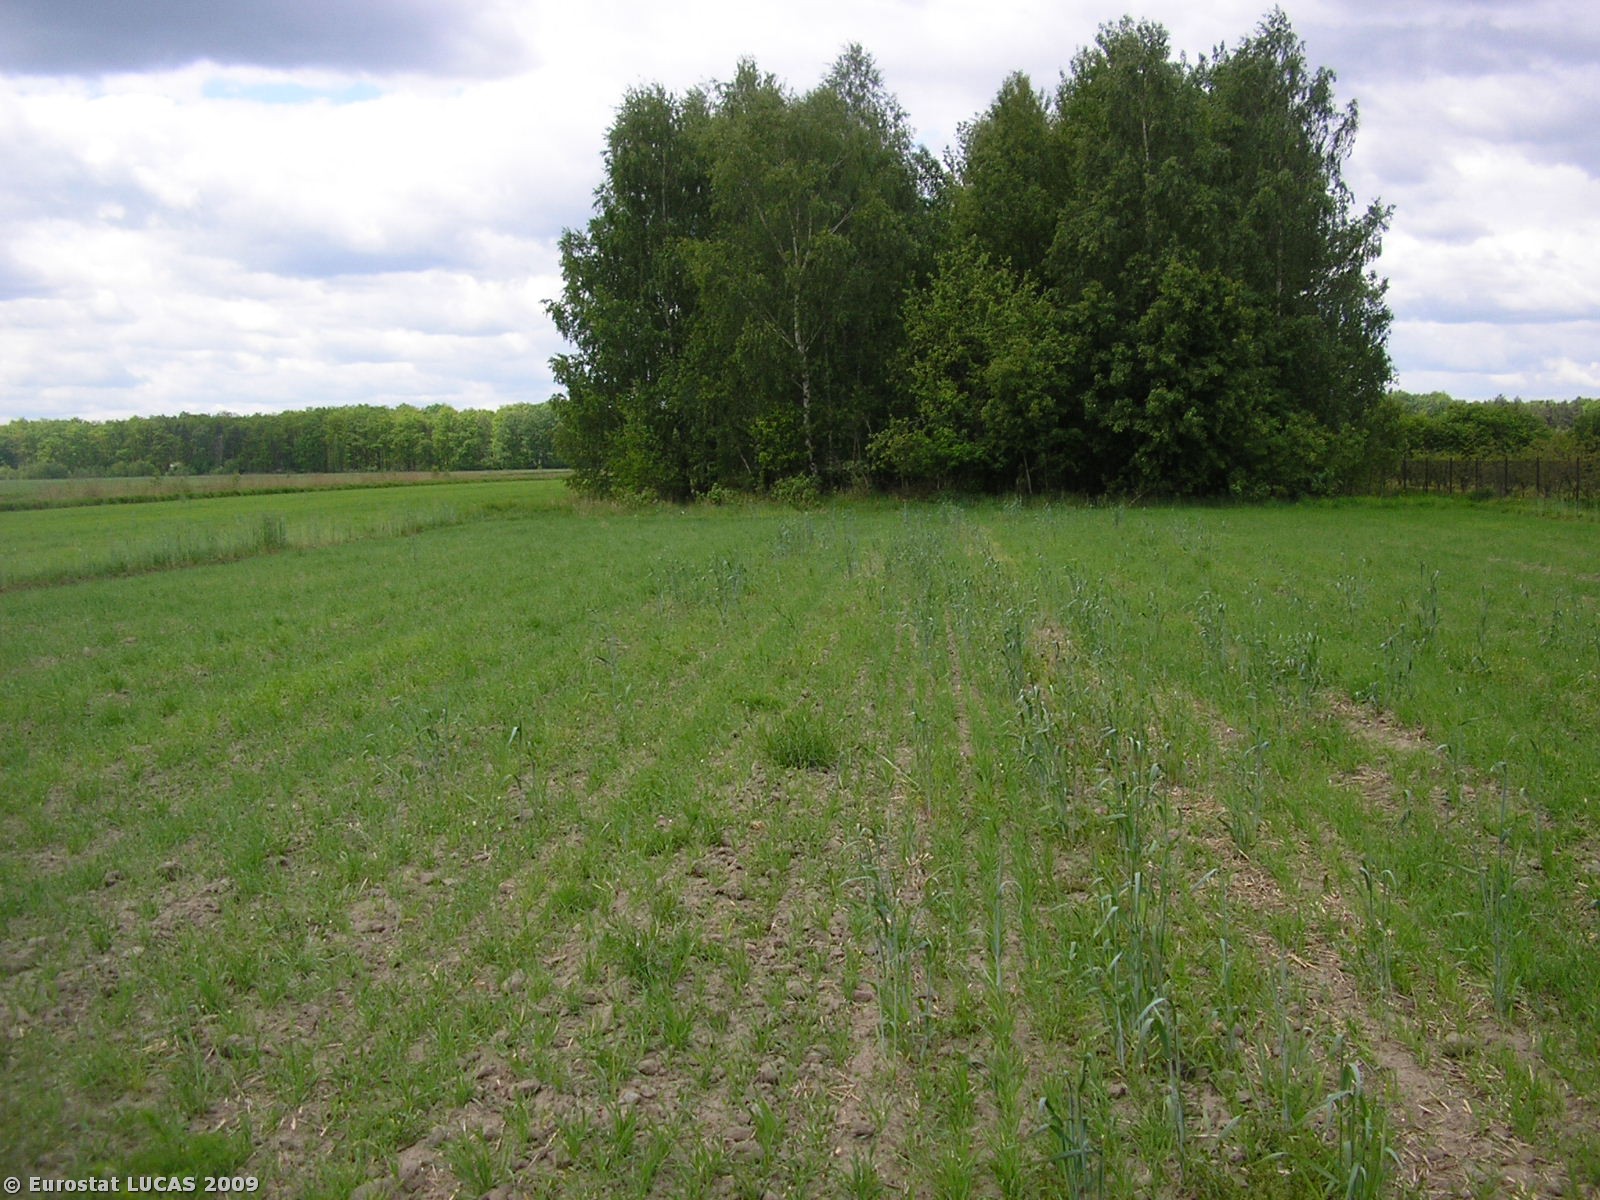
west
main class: Cropland
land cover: Barley
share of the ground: < 10 %
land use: Agriculture (excluding fallow land and kitchen gardens)
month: May
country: PL
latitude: 51.9621
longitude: 20.1196
